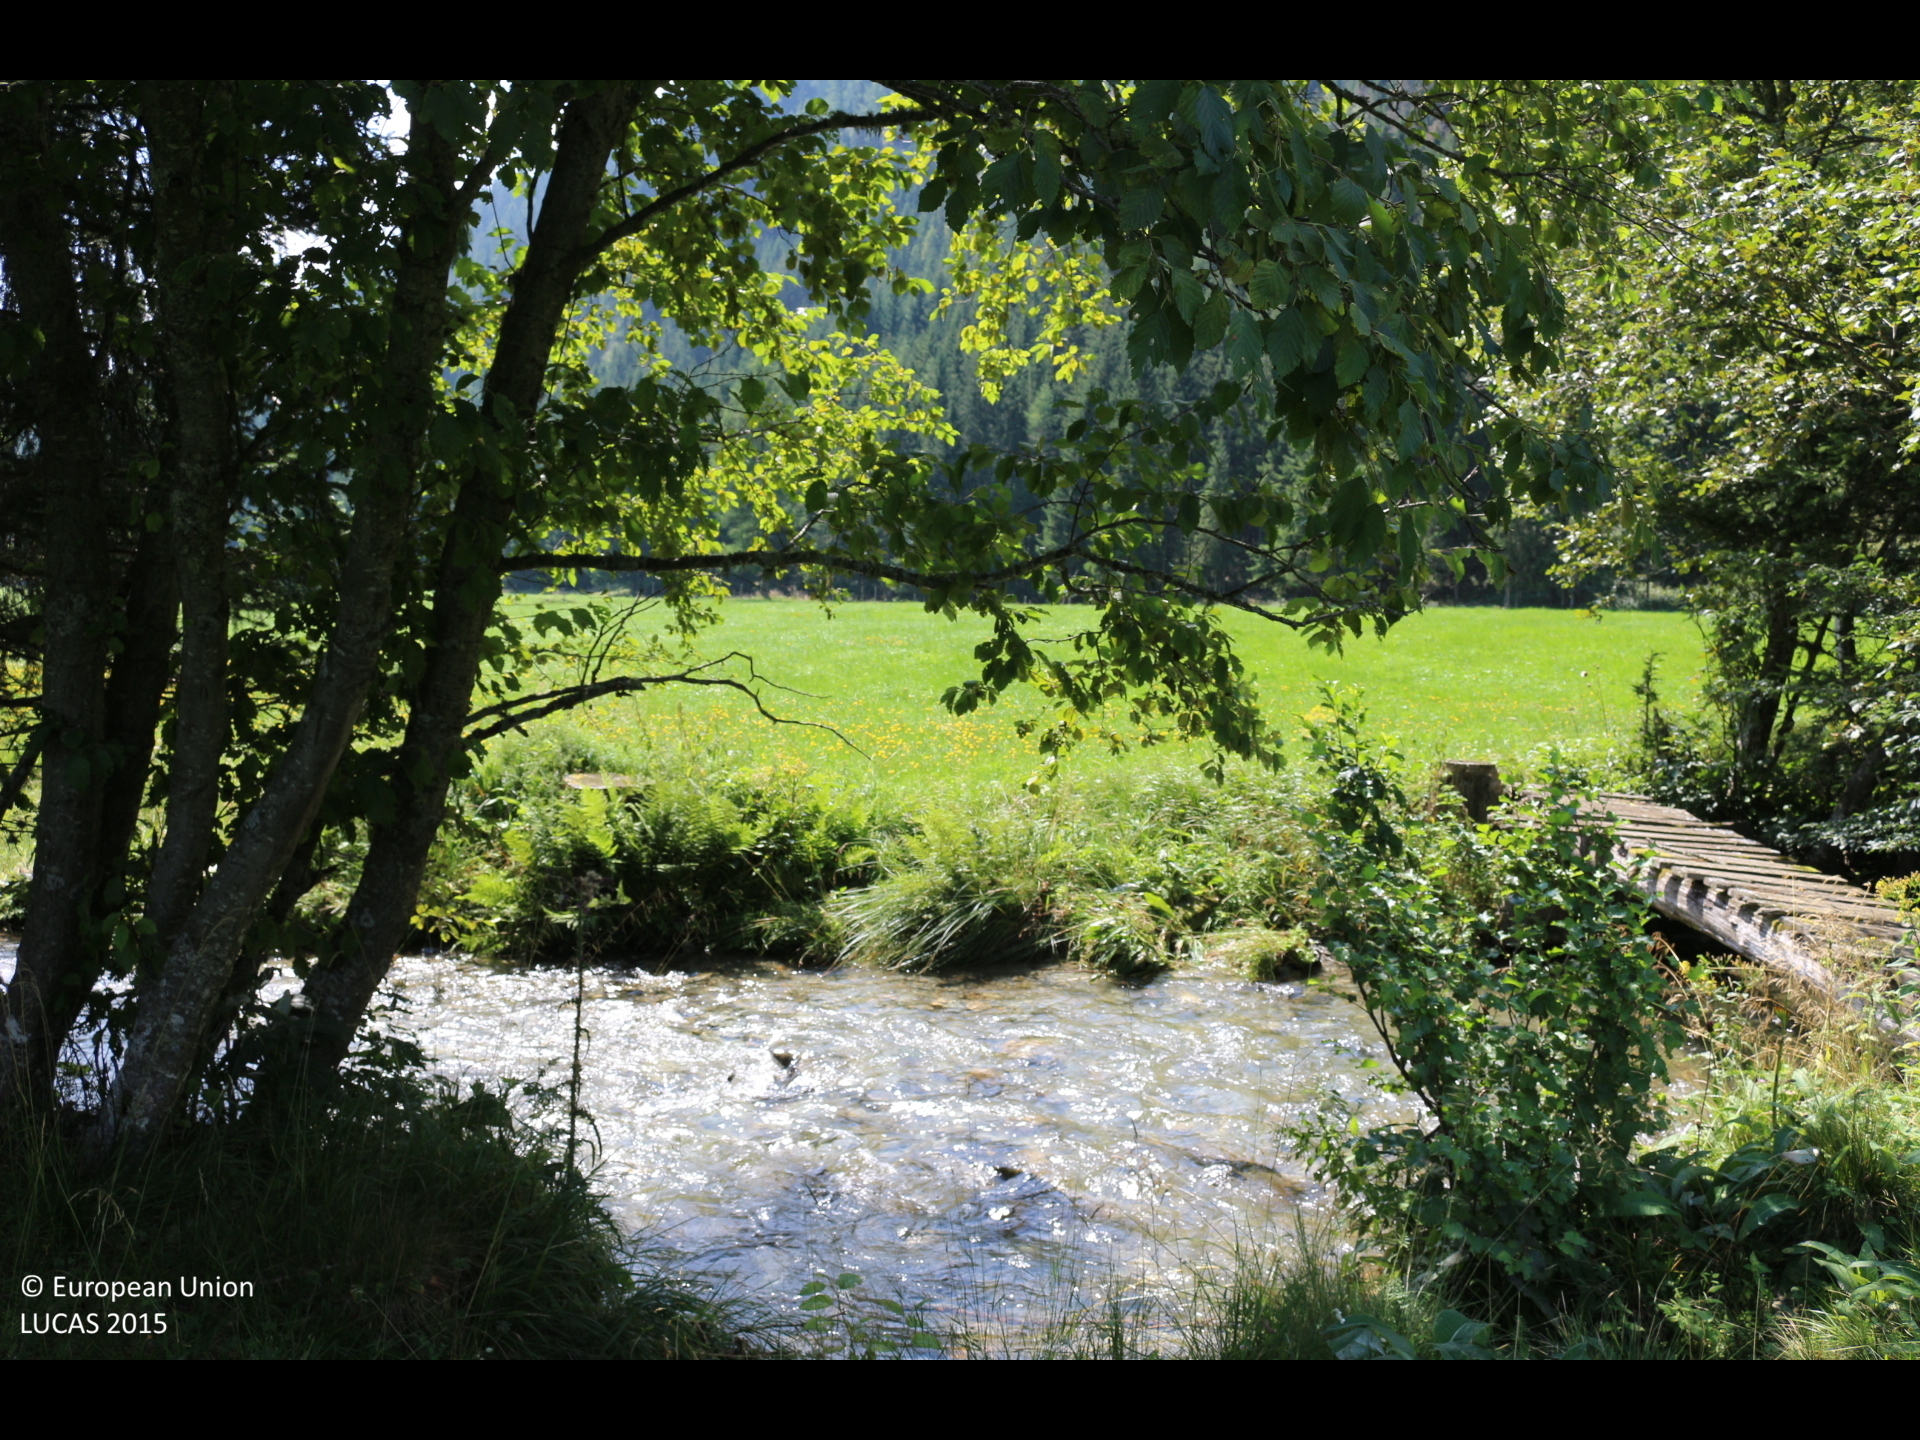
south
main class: Grassland
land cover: Grassland without tree/shrub cover
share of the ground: > 75 %
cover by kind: herbaceous plants 100 %
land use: Agriculture (excluding fallow land and kitchen gardens)
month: August
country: AT
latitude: 47.0283
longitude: 14.1428
